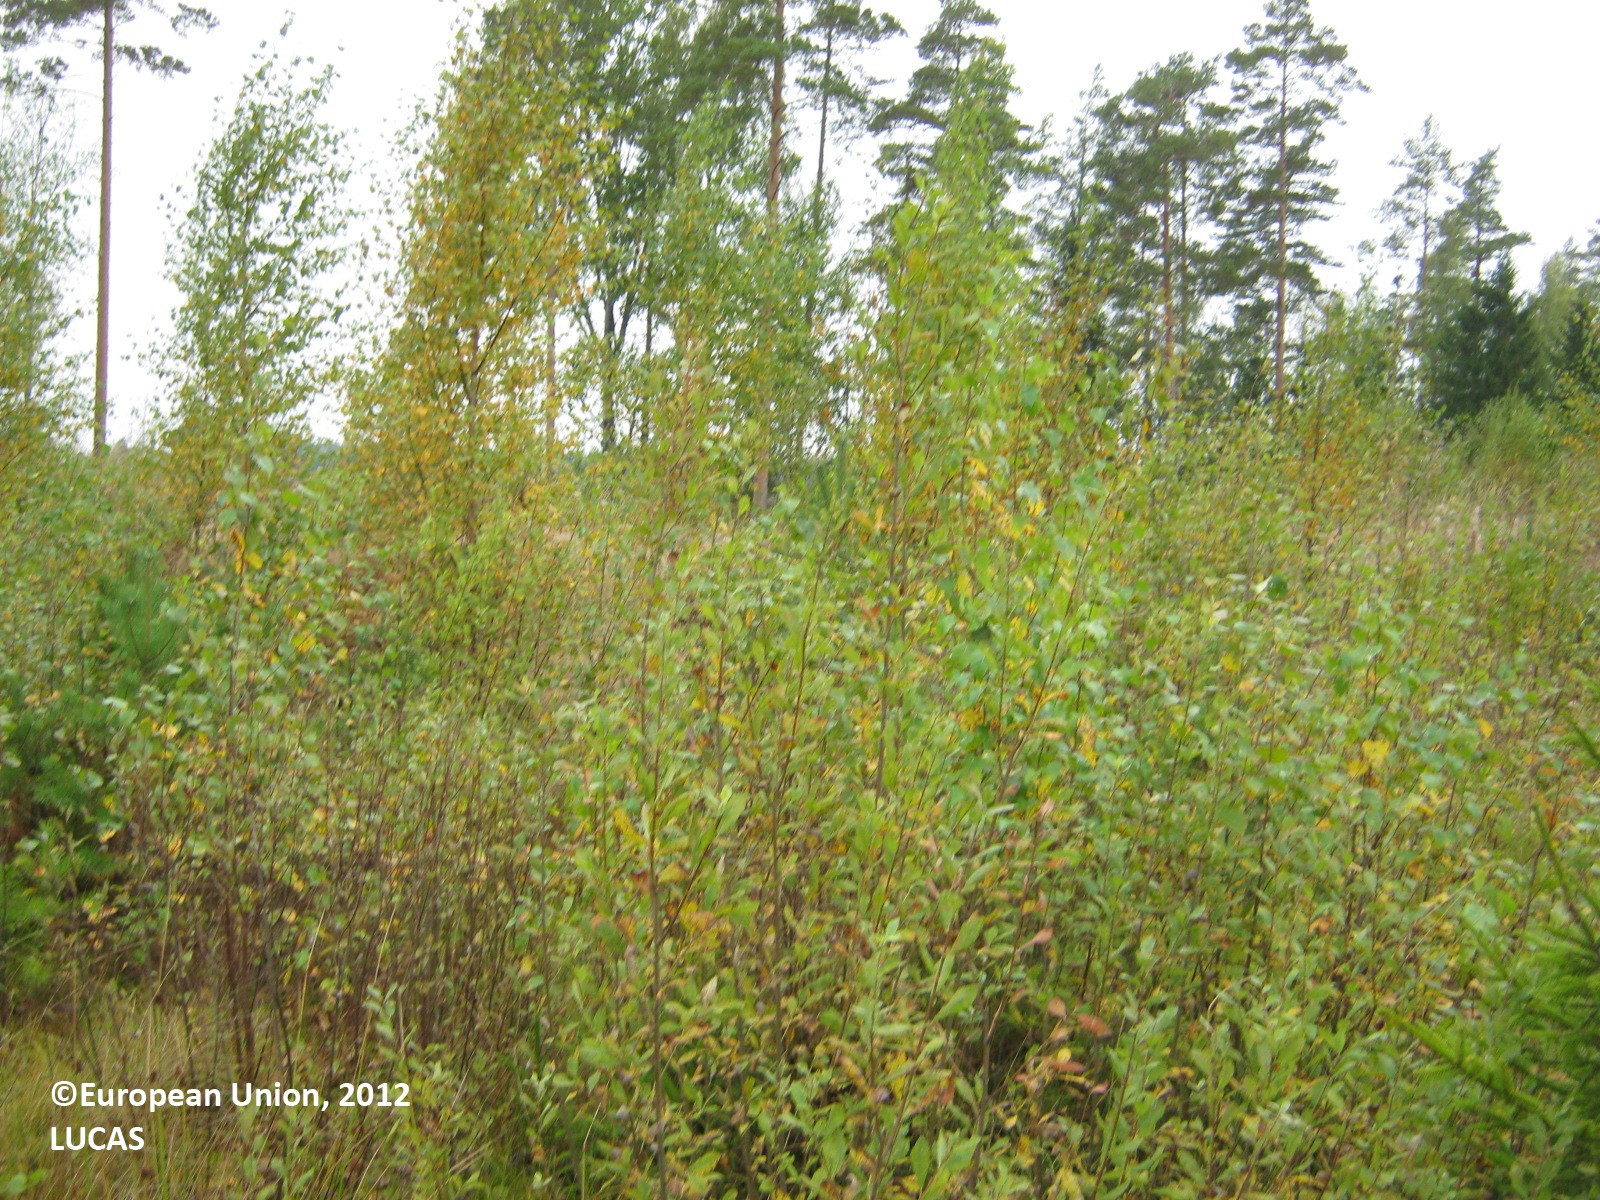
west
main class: Woodland
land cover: Broadleaved woodland
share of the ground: > 75 %
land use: Forestry
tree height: < 5 m
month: September
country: FI
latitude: 61.0228
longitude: 27.9039
